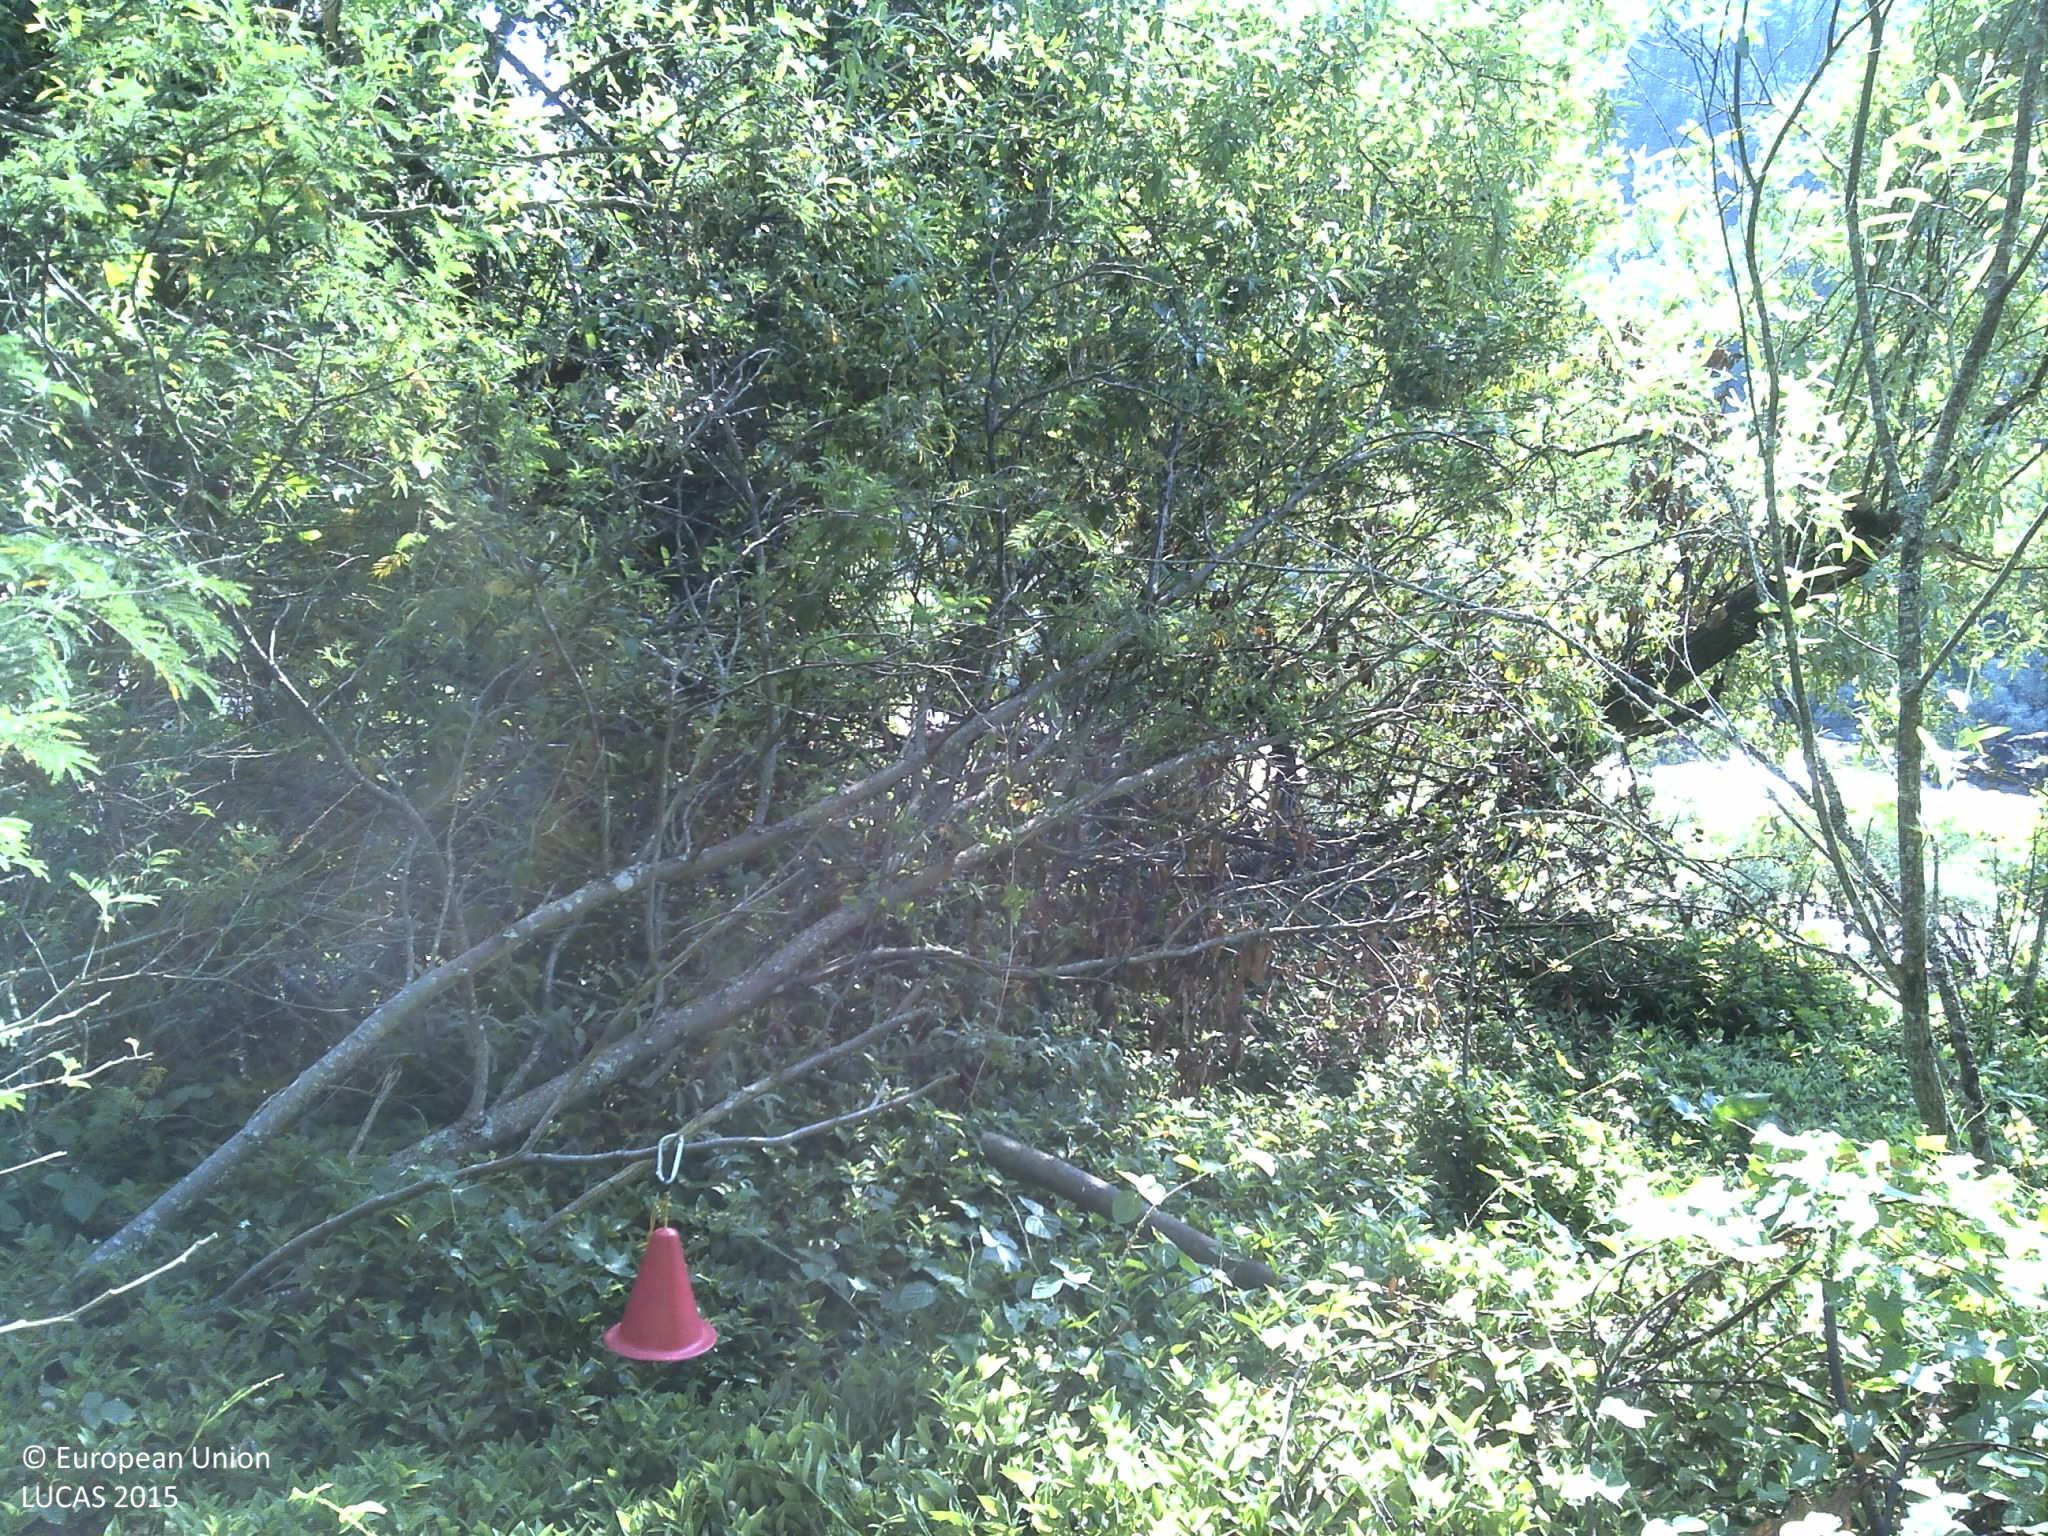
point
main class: Woodland
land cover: Broadleaved woodland
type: floodplain forest
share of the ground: > 75 %
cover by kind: broadleaved forest trees 70 %, unconsolidated bare surface 15 %, herbaceous plants 10 %, shrubs 5 %
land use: Semi-natural and natural areas not in use
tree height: > 5 m
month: June
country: PT
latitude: 42.1519
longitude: -8.2003
